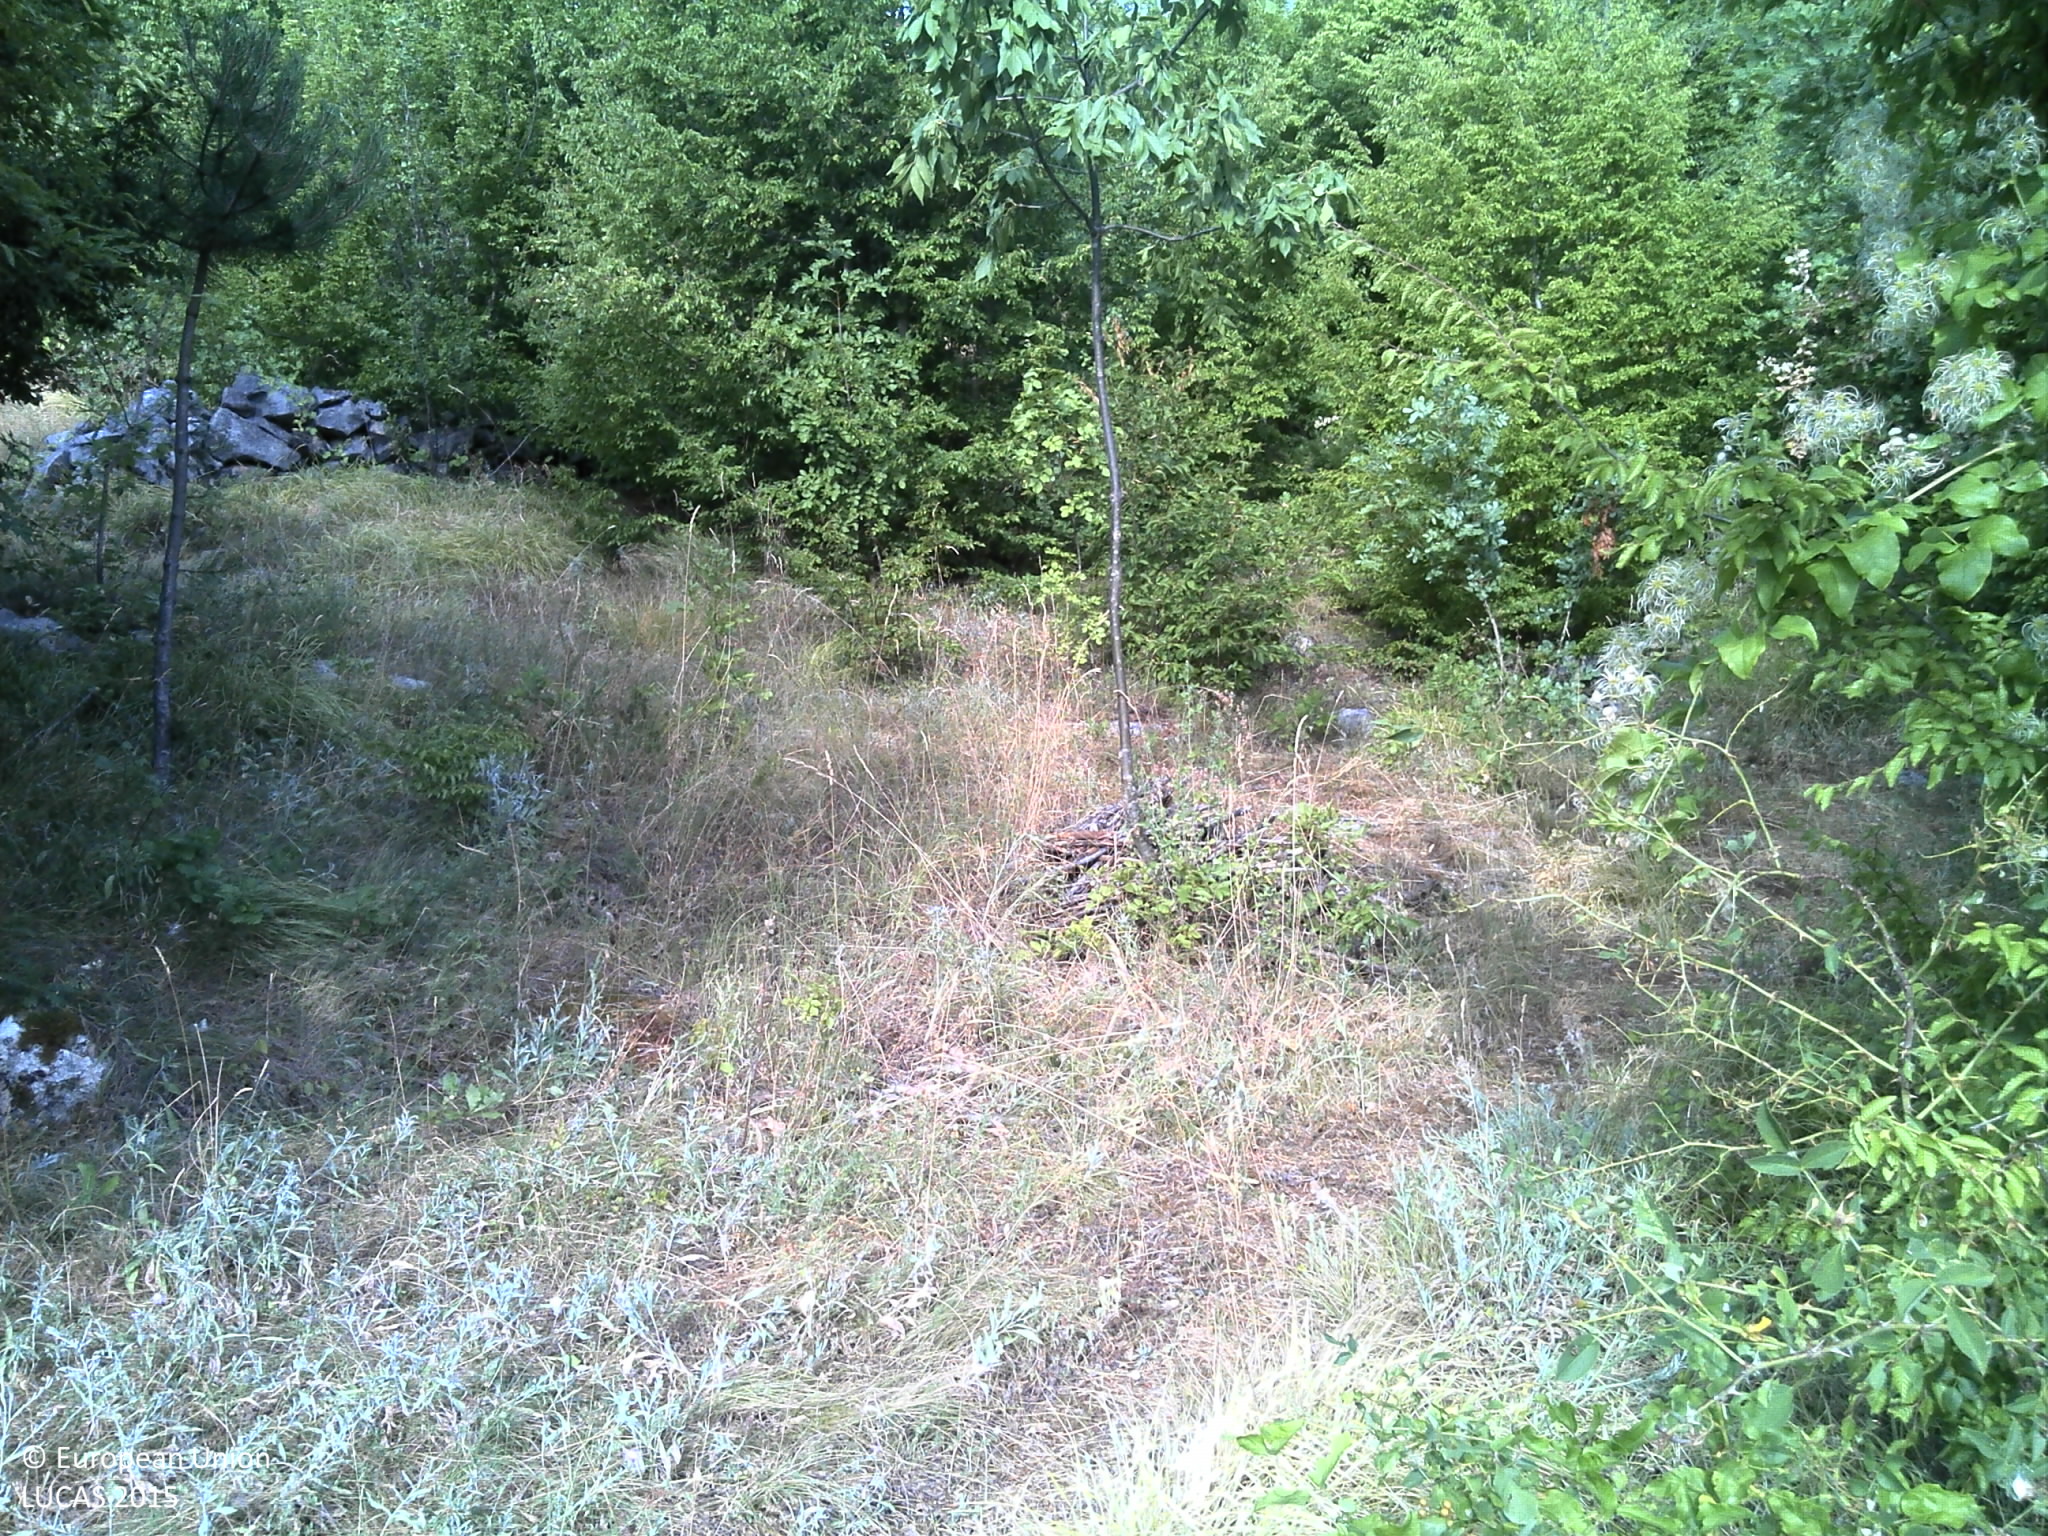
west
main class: Shrubland
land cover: Shrubland with sparse tree cover
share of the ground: > 75 %
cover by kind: shrubs 65 %, herbaceous plants 20 %, broadleaved forest trees 5 %, lichens and mosses 5 %, consolidated bare surface 5 %
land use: Semi-natural and natural areas not in use
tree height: < 5 m
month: July
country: HR
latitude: 43.4556
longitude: 17.0978
